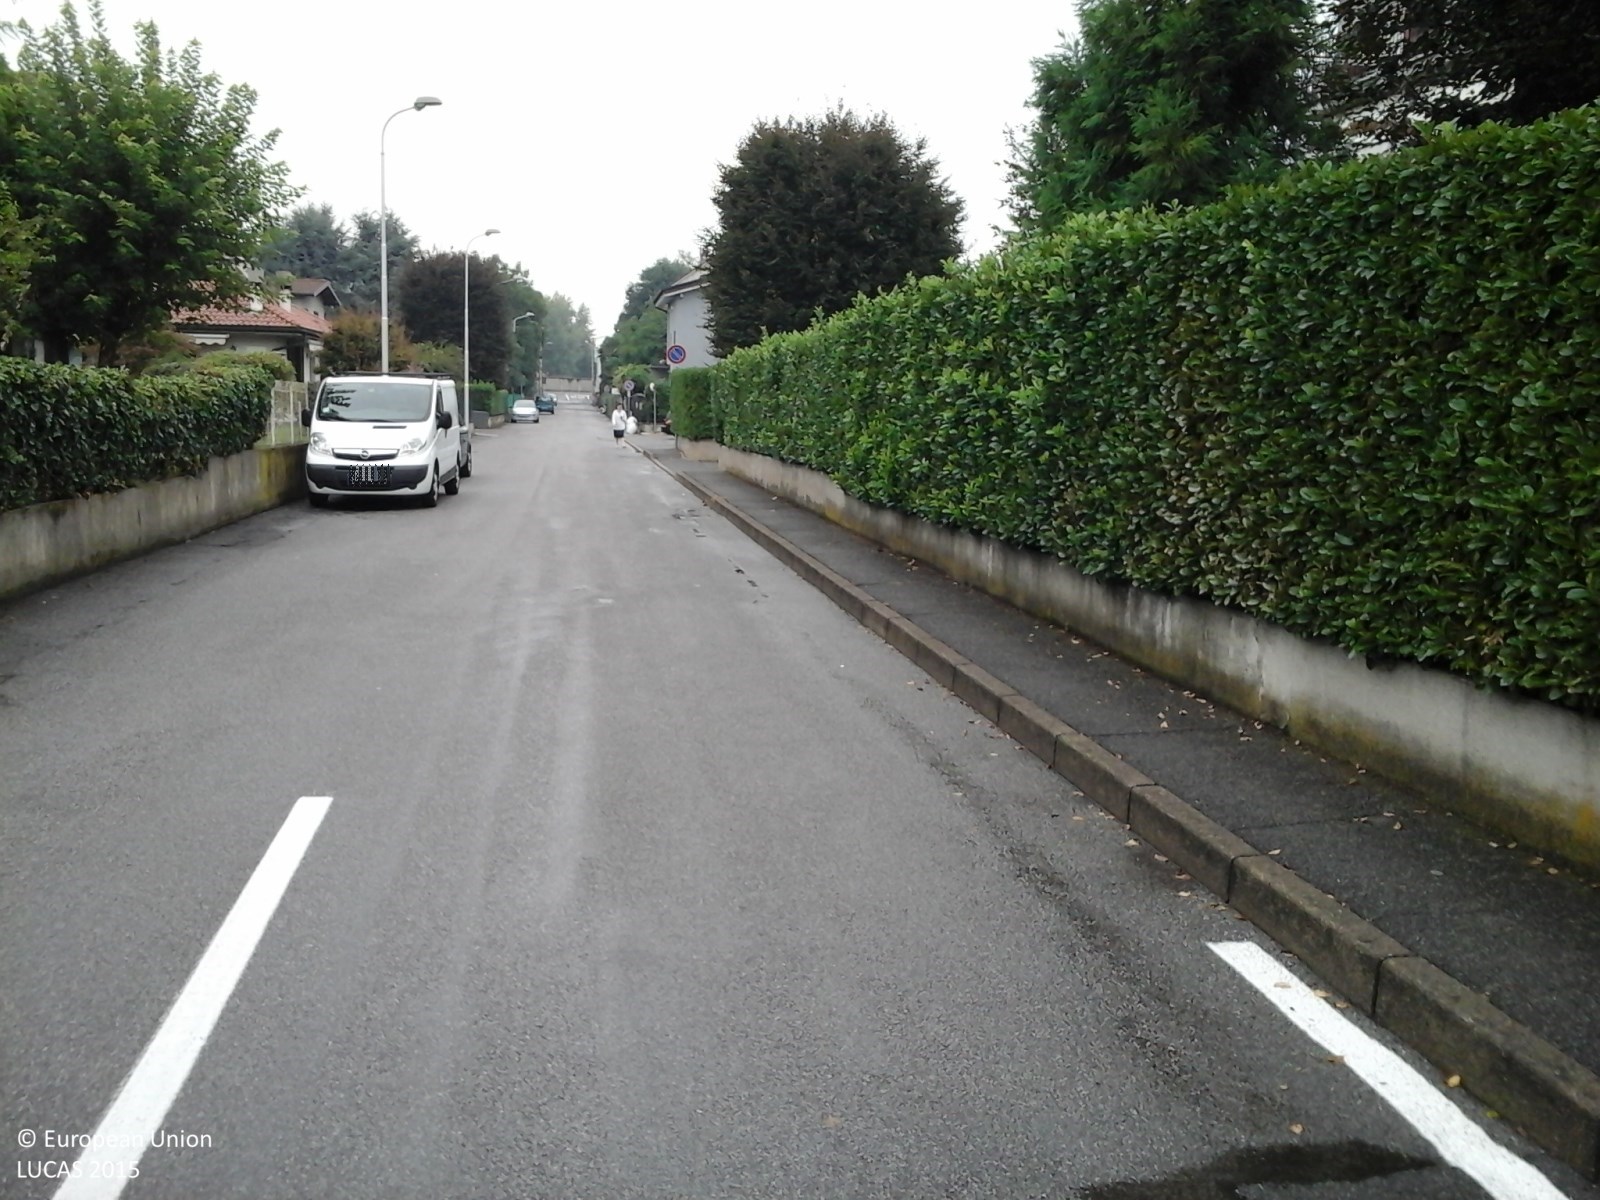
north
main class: Grassland
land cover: Grassland with sparse tree/shrub cover
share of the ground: > 75 %
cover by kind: herbaceous plants 85 %, shrubs 10 %, broadleaved forest trees 5 %
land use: Residential
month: August
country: IT
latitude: 45.6987
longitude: 9.0896
